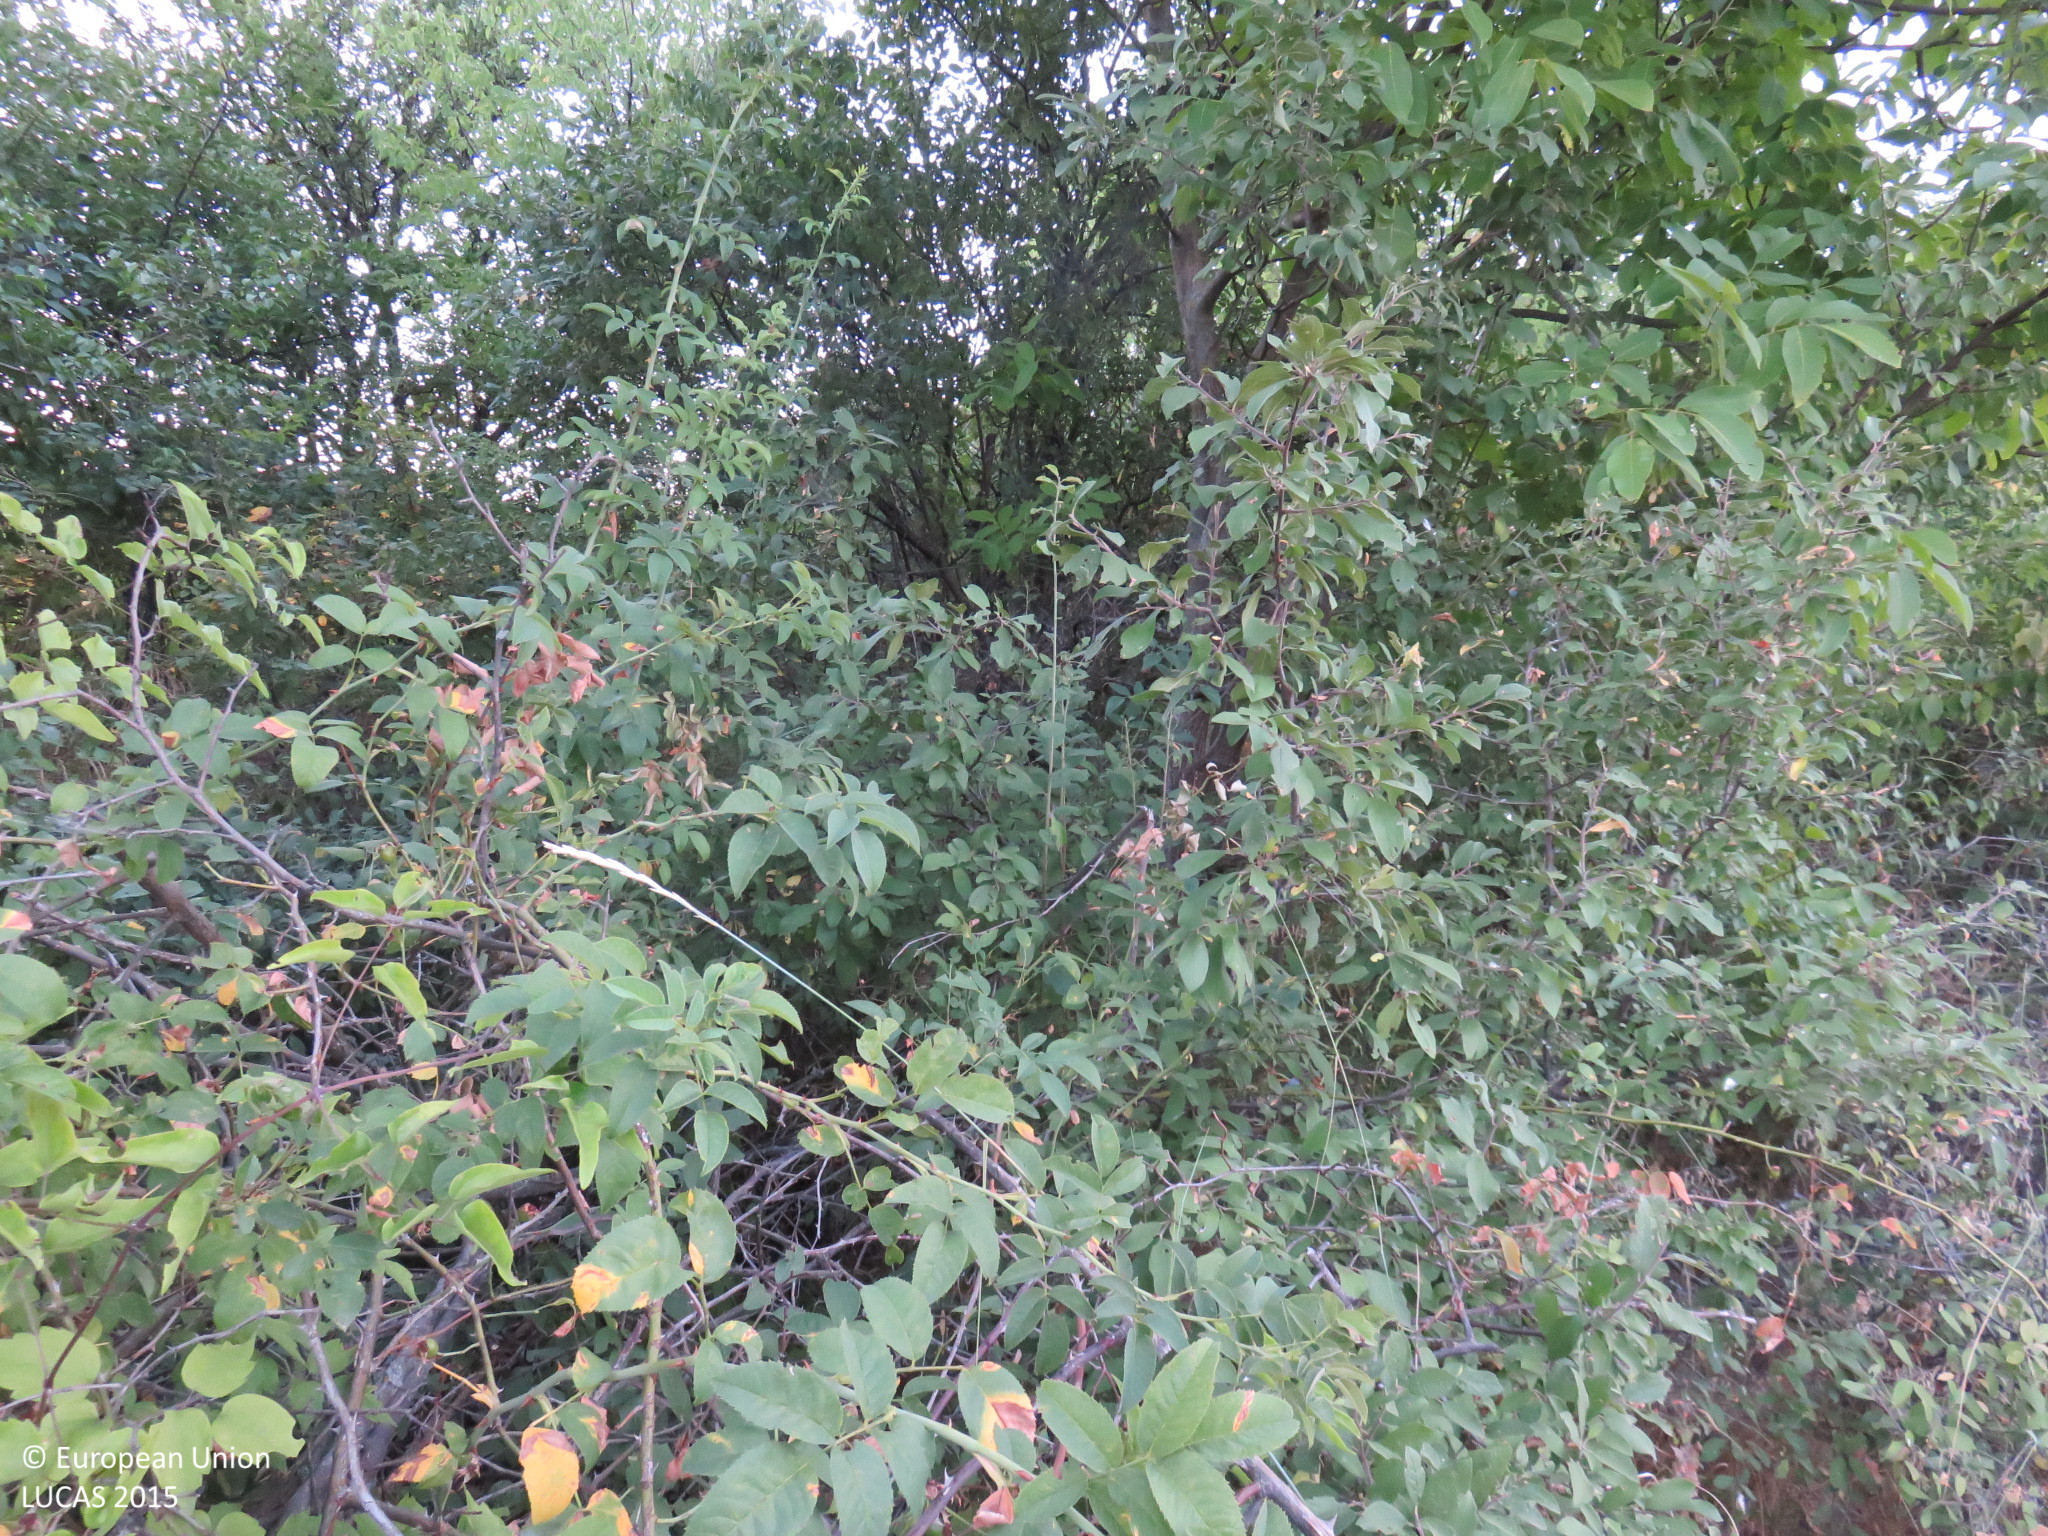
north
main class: Woodland
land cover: Broadleaved woodland
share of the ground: > 75 %
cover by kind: broadleaved forest trees 50 %, shrubs 50 %
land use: Semi-natural and natural areas not in use
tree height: > 5 m
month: July
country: BG
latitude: 43.1873
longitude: 25.1936
